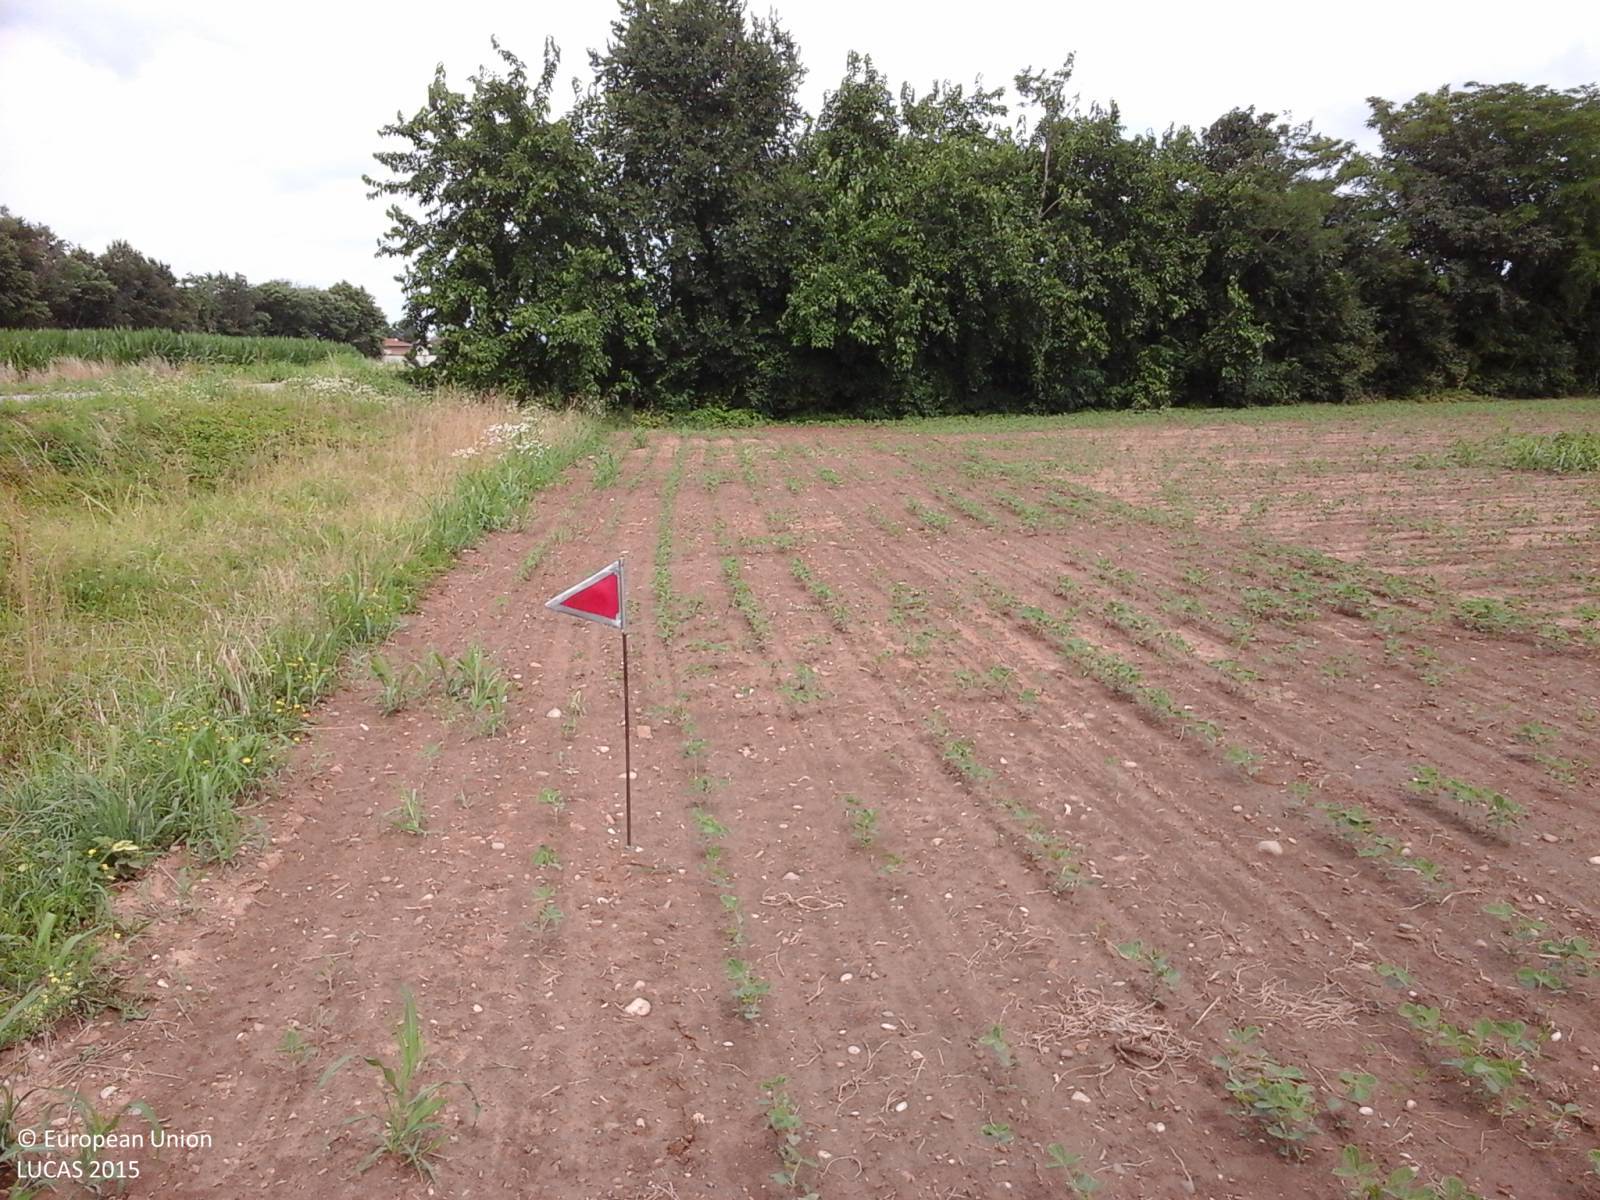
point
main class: Cropland
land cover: Soya
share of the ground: 10 - 25 %
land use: Agriculture (excluding fallow land and kitchen gardens)
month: June
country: IT
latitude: 45.9958
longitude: 13.2371
